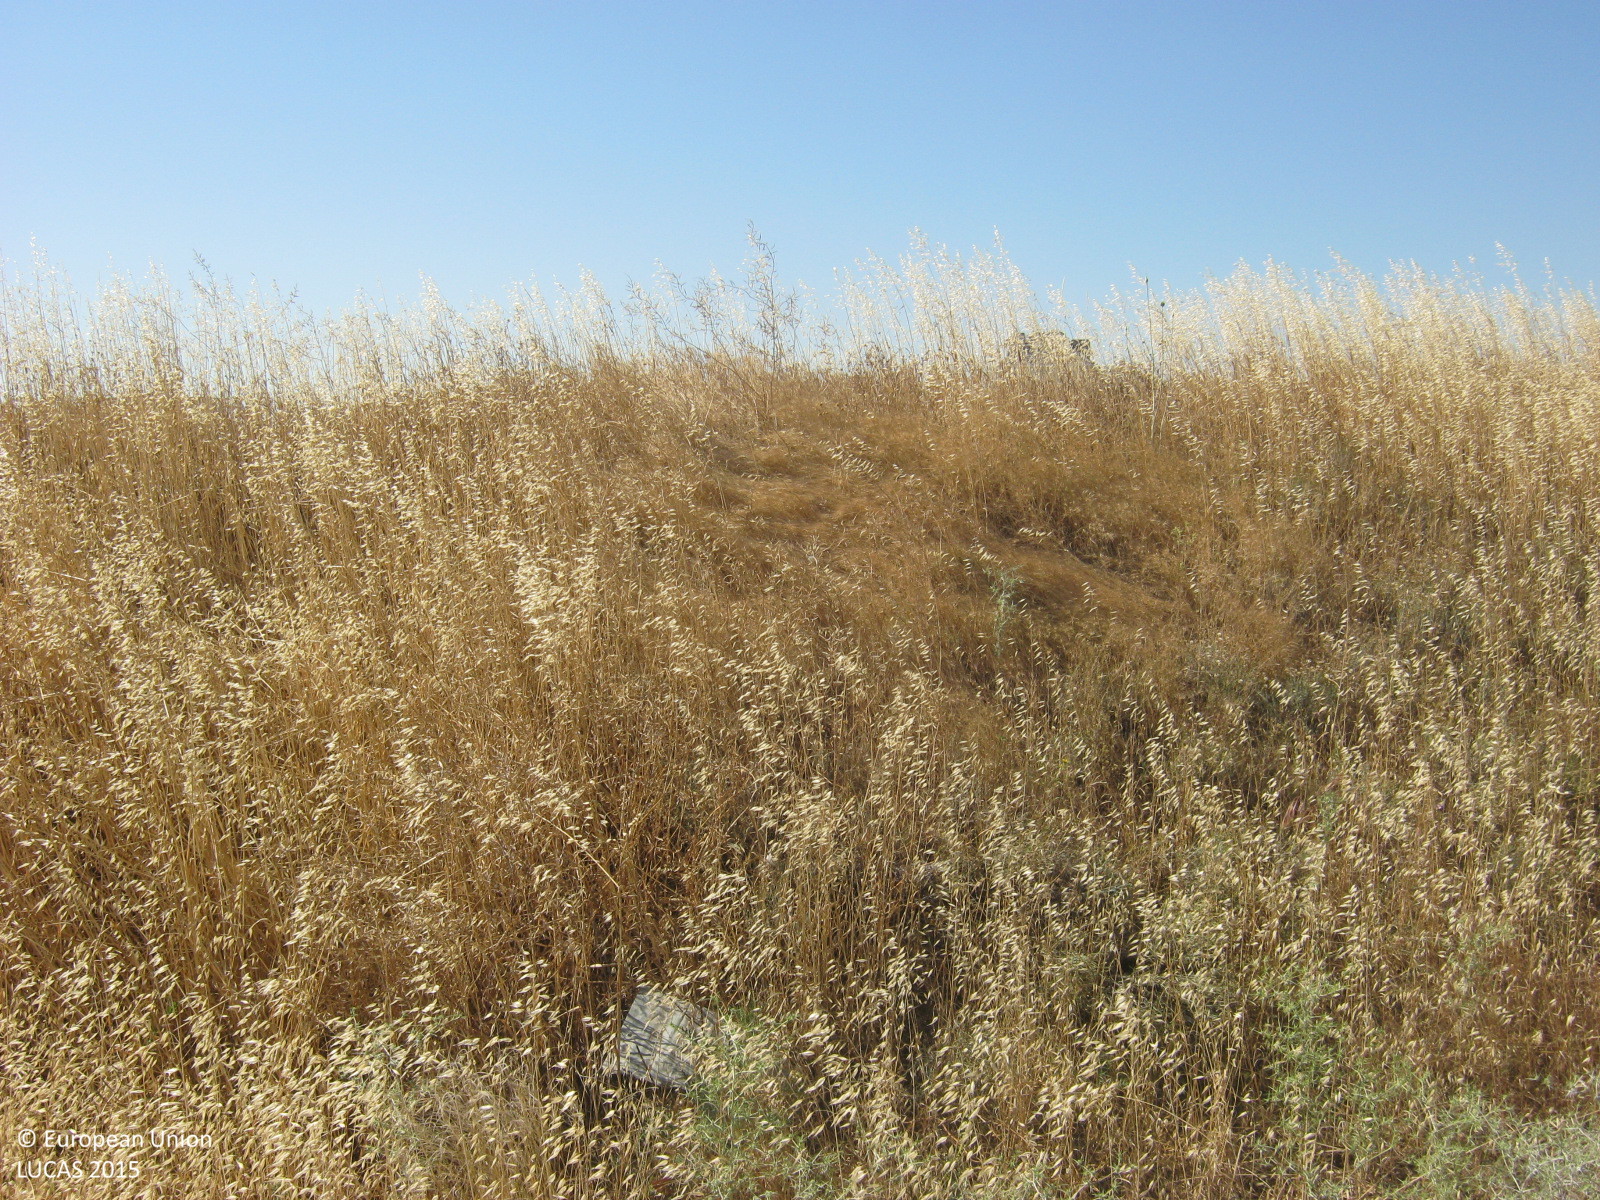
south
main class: Grassland
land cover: Grassland with sparse tree/shrub cover
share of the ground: > 75 %
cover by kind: herbaceous plants 90 %, broadleaved forest trees 5 %, shrubs 5 %
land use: Semi-natural and natural areas not in use
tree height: < 5 m
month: May
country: CY
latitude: 35.1565
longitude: 33.4135
